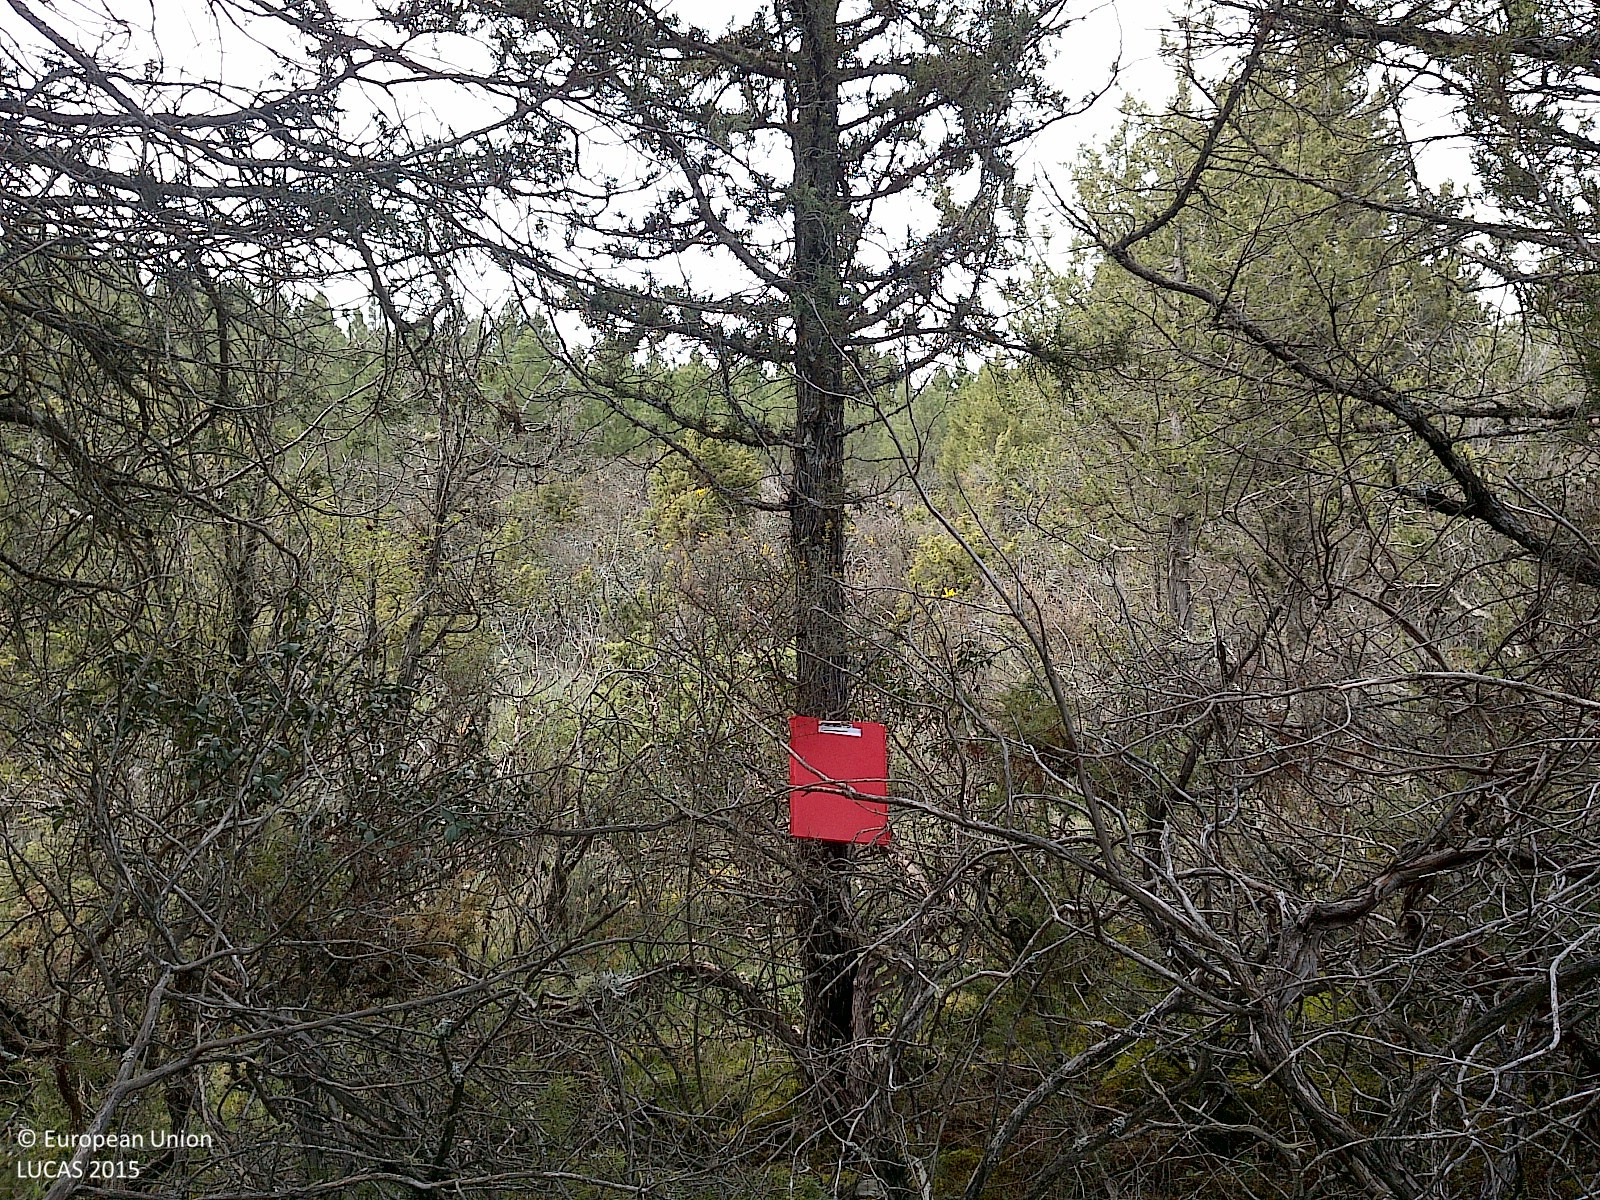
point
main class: Woodland
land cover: Other coniferous woodland
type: coniferous forest of the mediterranean region
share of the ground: 25 - 50 %
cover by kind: shrubs 65 %, coniferous forest trees 30 %, herbaceous plants 5 %
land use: Semi-natural and natural areas not in use
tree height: > 5 m
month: April
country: ES
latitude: 41.6982
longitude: -3.0336
